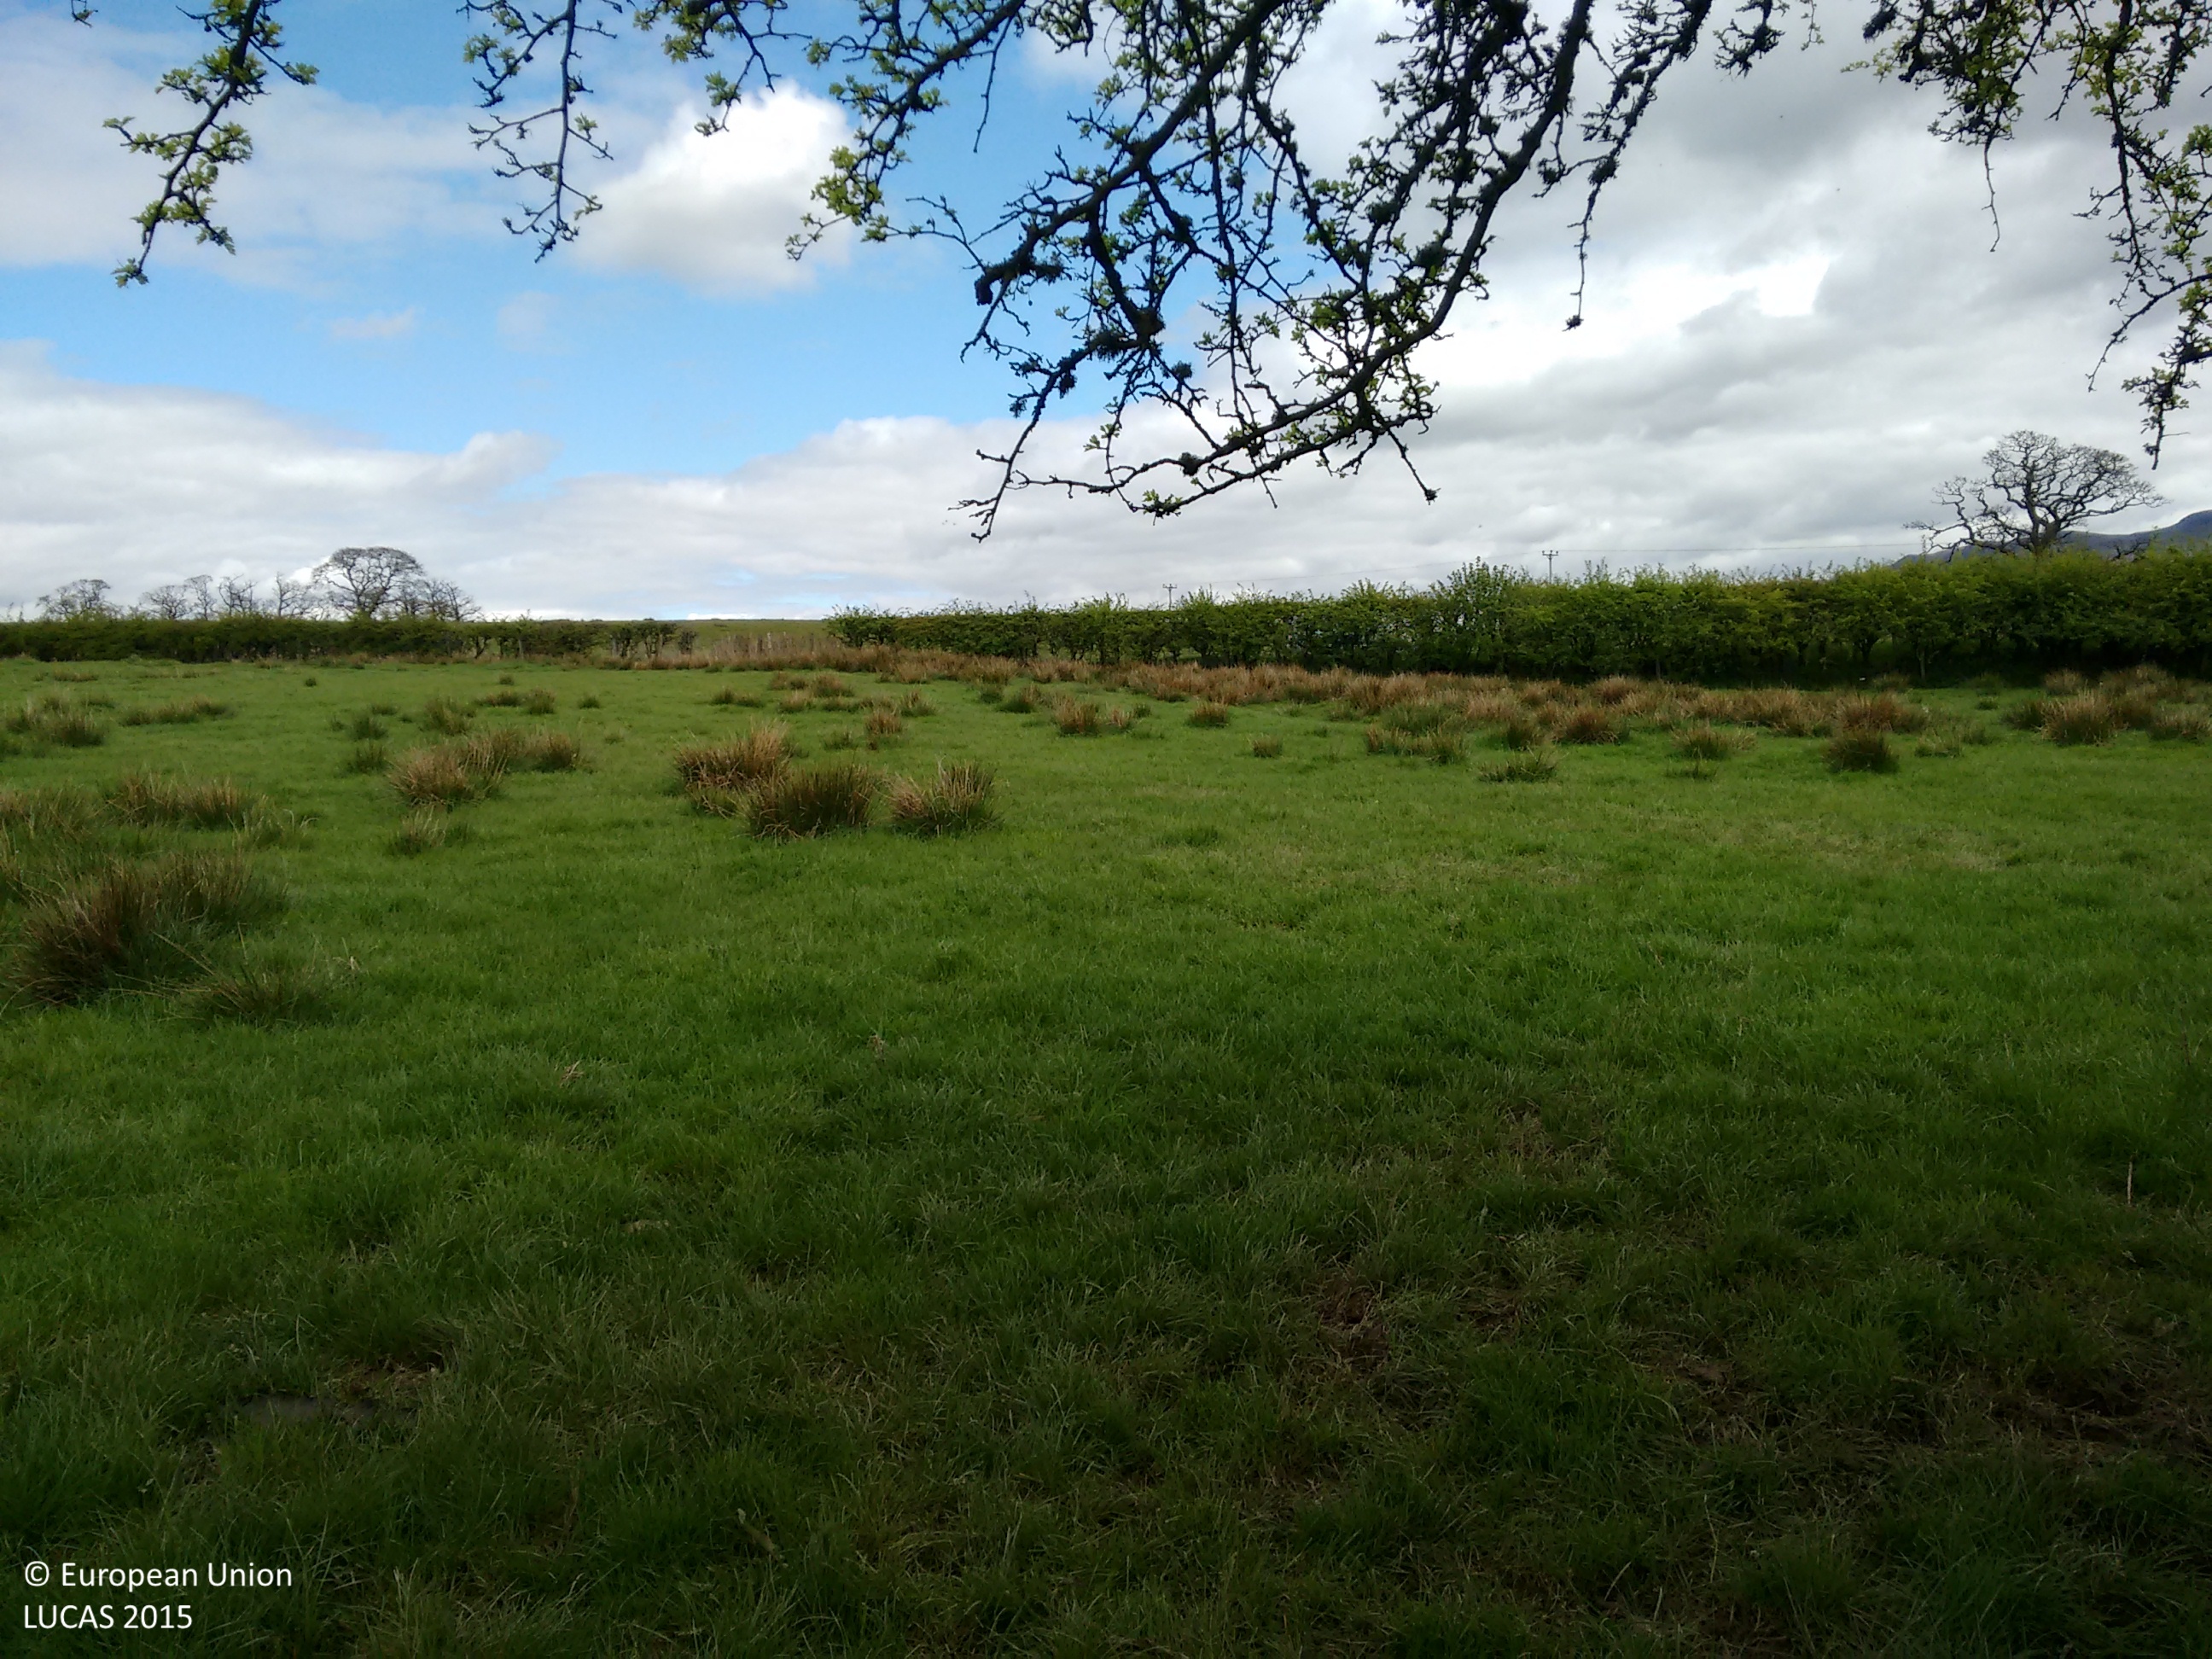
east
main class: Grassland
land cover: Grassland without tree/shrub cover
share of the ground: > 75 %
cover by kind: herbaceous plants 100 %
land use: Agriculture (excluding fallow land and kitchen gardens)
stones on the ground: < 10 %
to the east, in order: Grassland without tree/shrub cover; Fences; Managed hedges; Grass margins; Paved roads, cycling and walking lanes; Grass margins; Fences; Grassland without tree/shrub cover; Single bushes/trees; Grassland without tree/shrub cover; Electric lines; Grassland without tree/shrub cover; Fences; Grassland without tree/shrub cover
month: May
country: GB
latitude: 56.0466
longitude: -4.3999
